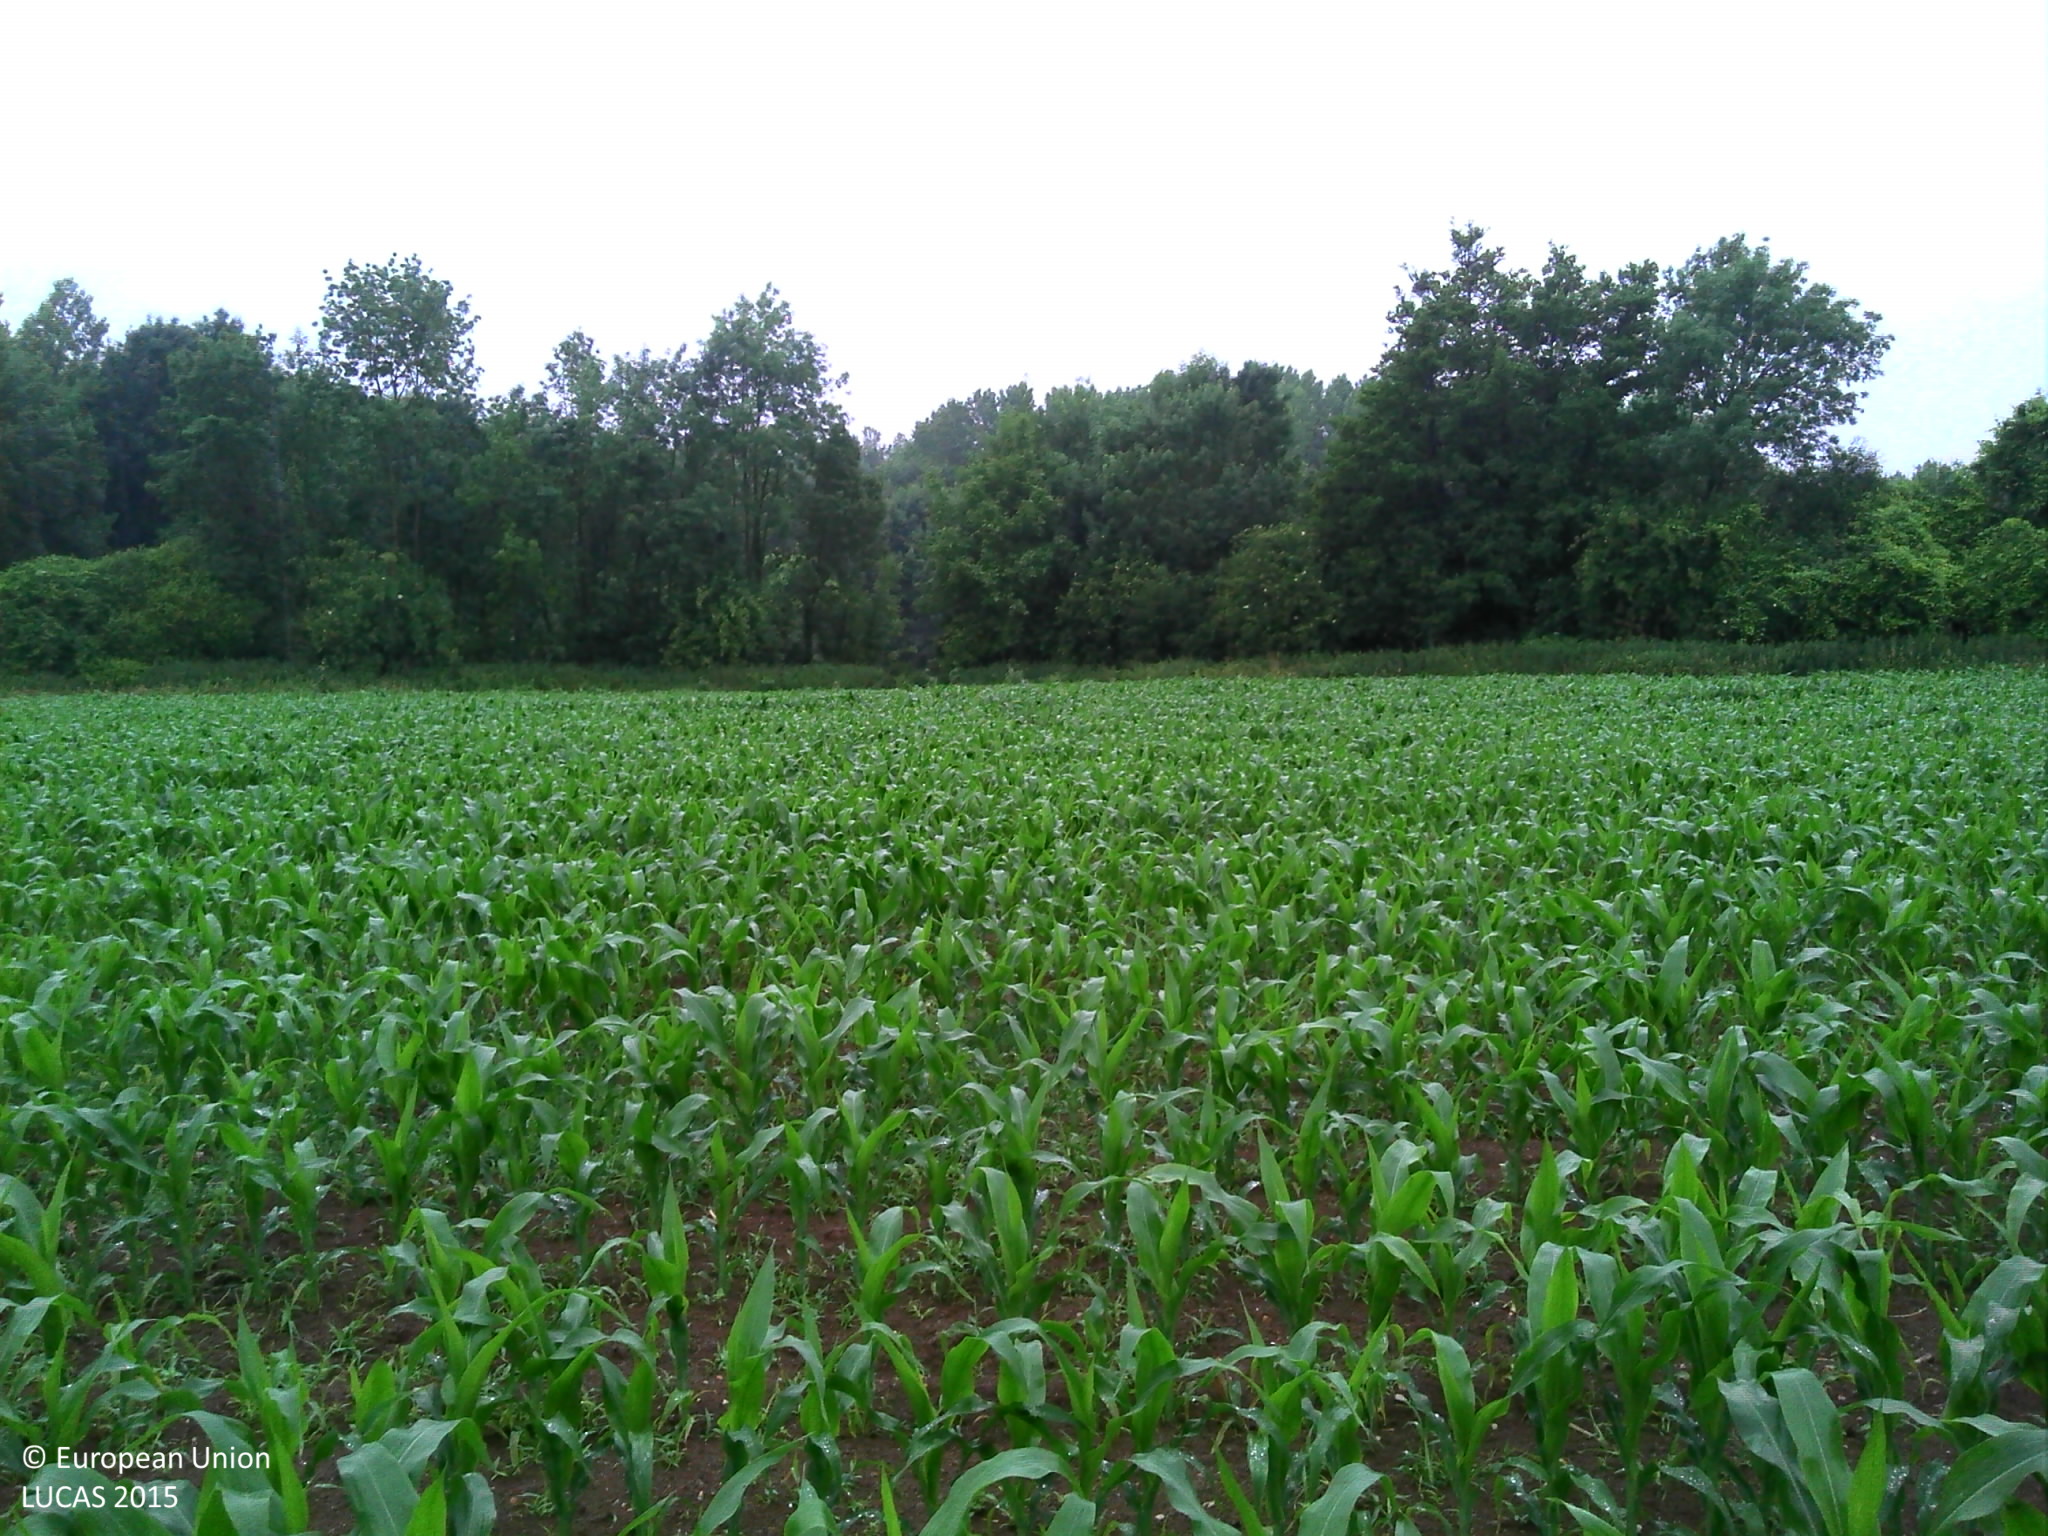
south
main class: Cropland
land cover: Maize
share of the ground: 25 - 50 %
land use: Agriculture (excluding fallow land and kitchen gardens)
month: June
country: FR
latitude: 46.7000
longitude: 0.4209
